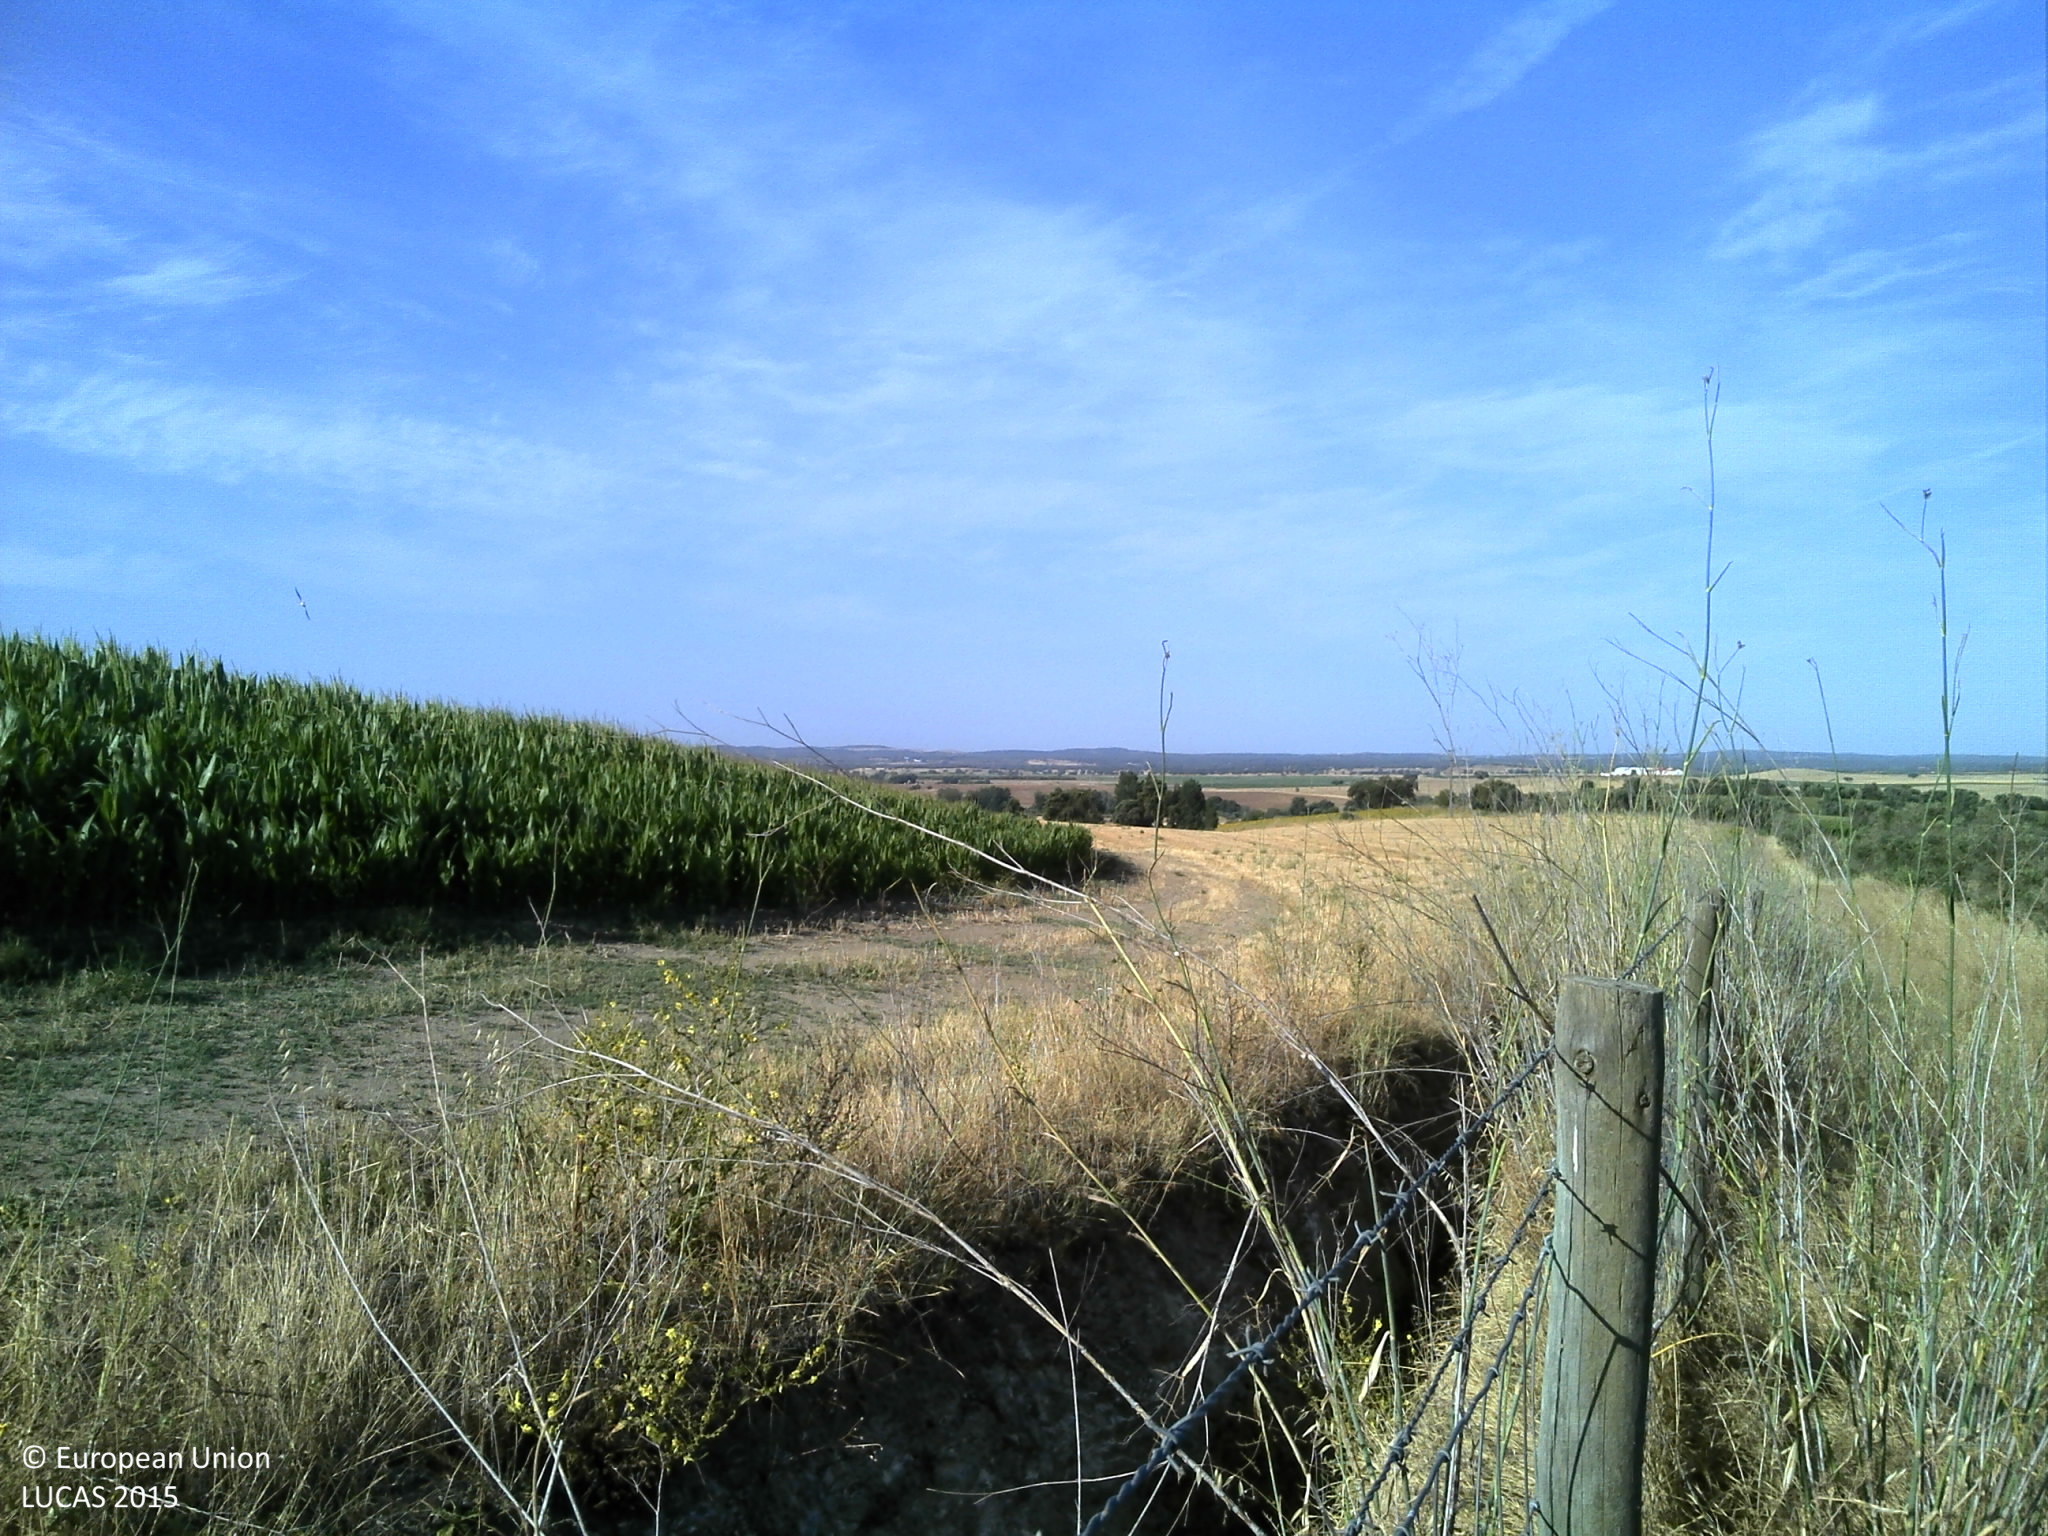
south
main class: Cropland
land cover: Maize
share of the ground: > 75 %
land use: Agriculture (excluding fallow land and kitchen gardens)
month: July
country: PT
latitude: 38.4518
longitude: -7.7369
